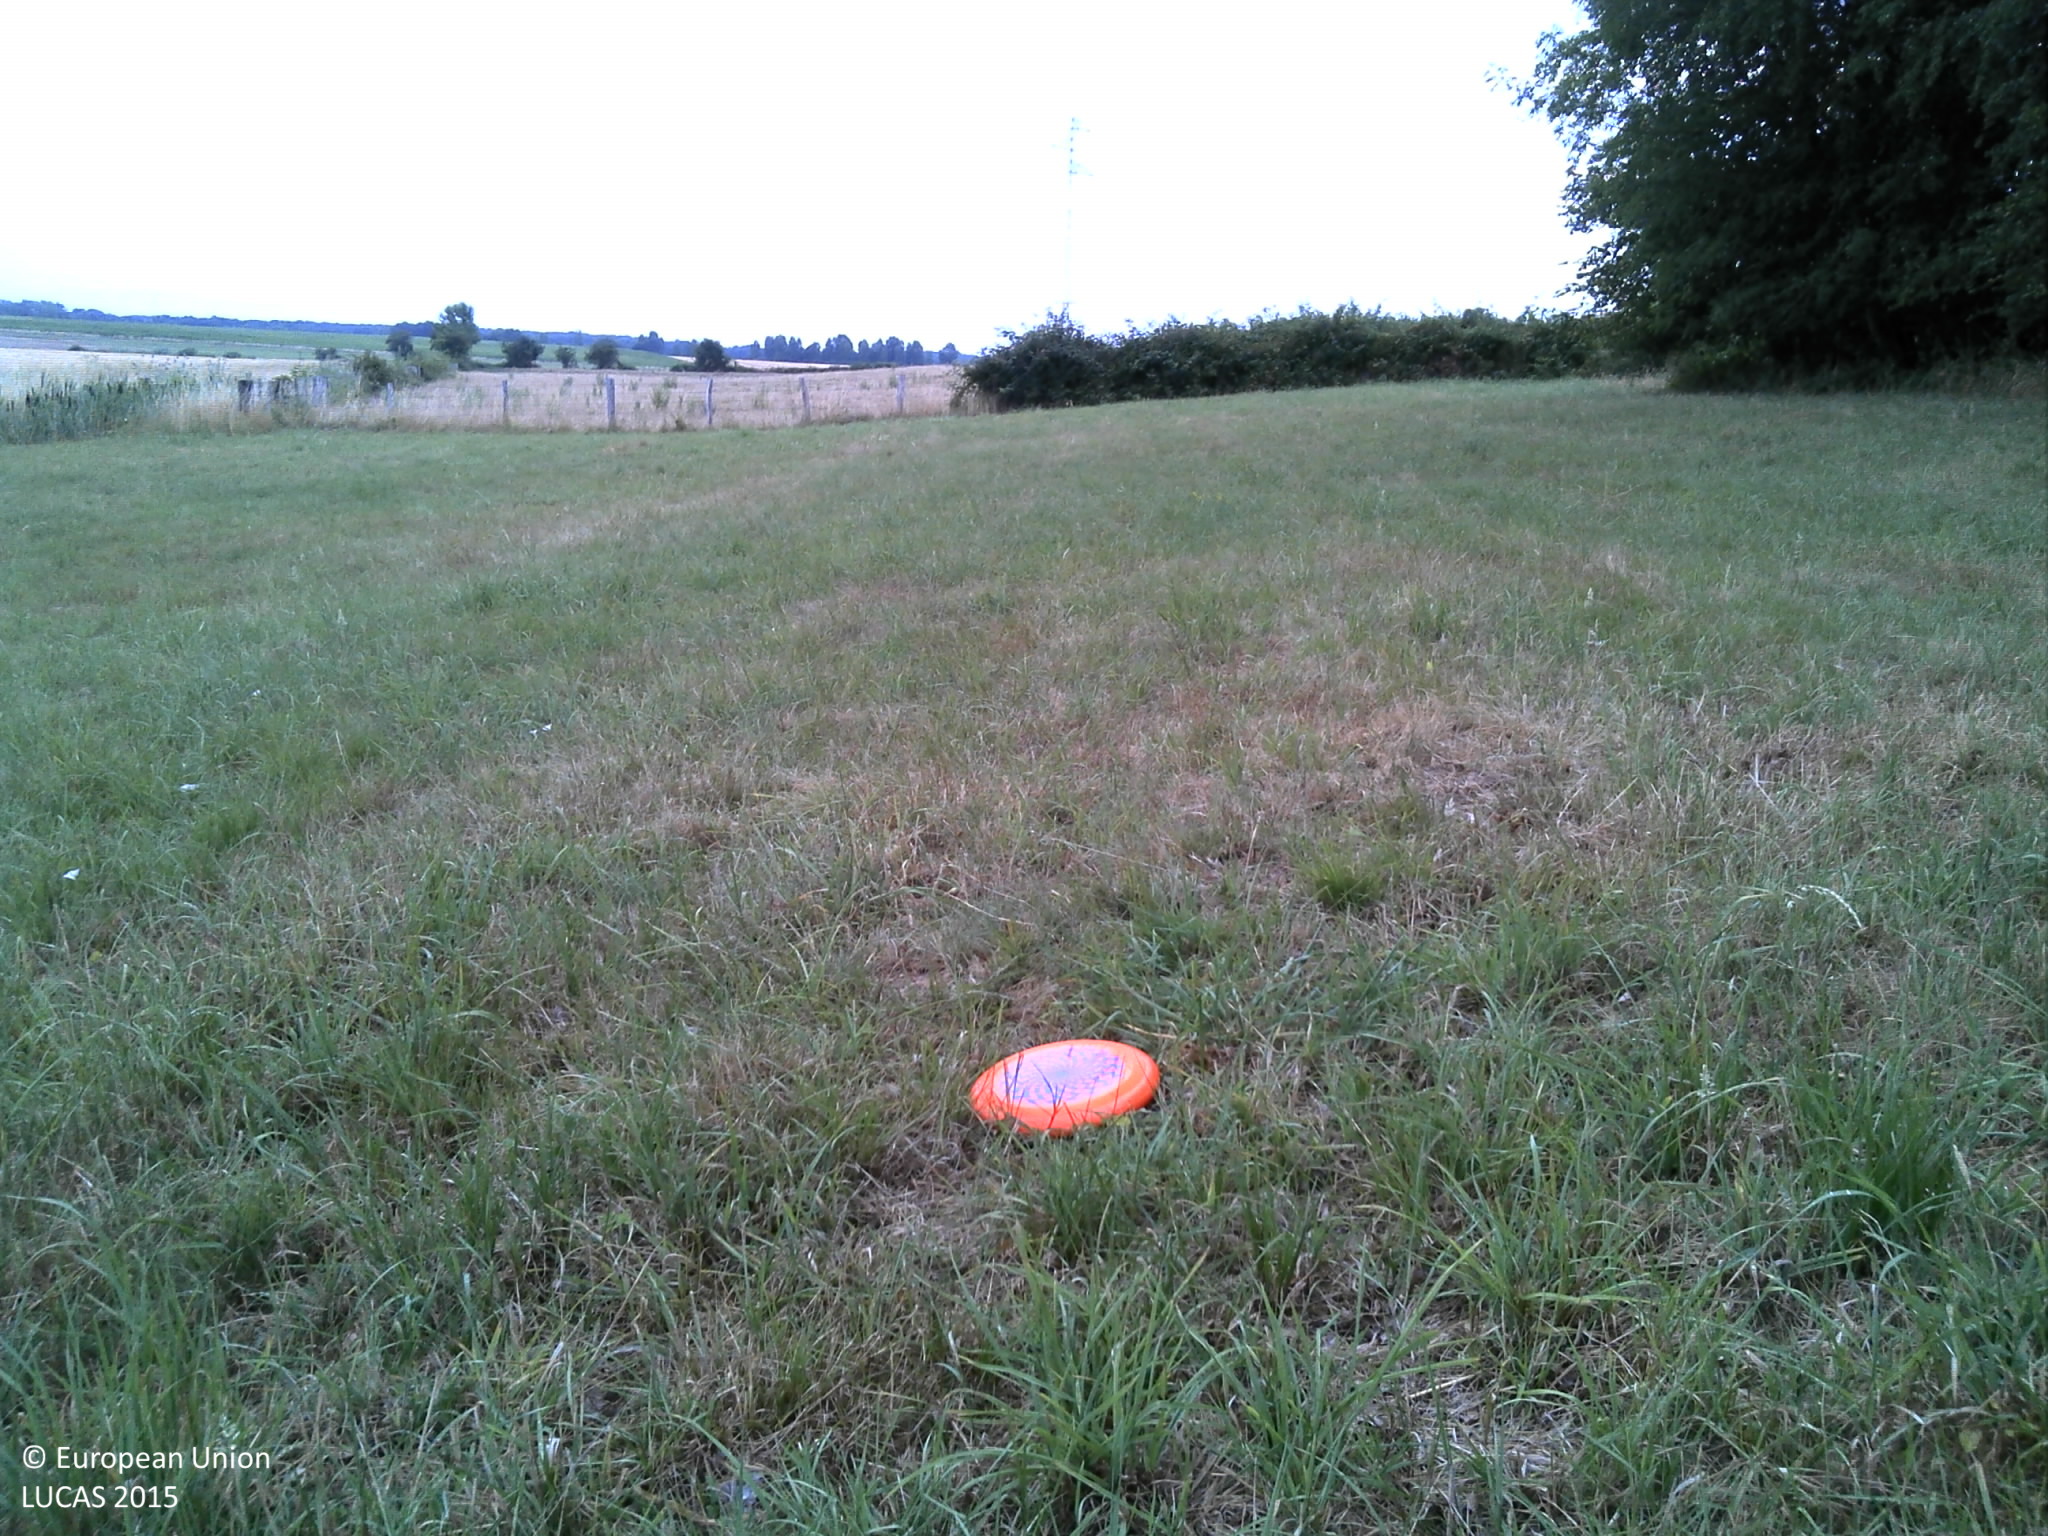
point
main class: Grassland
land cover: Grassland without tree/shrub cover
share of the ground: > 75 %
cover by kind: herbaceous plants 100 %
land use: Agriculture (excluding fallow land and kitchen gardens)
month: July
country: FR
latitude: 48.5457
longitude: 4.6741
